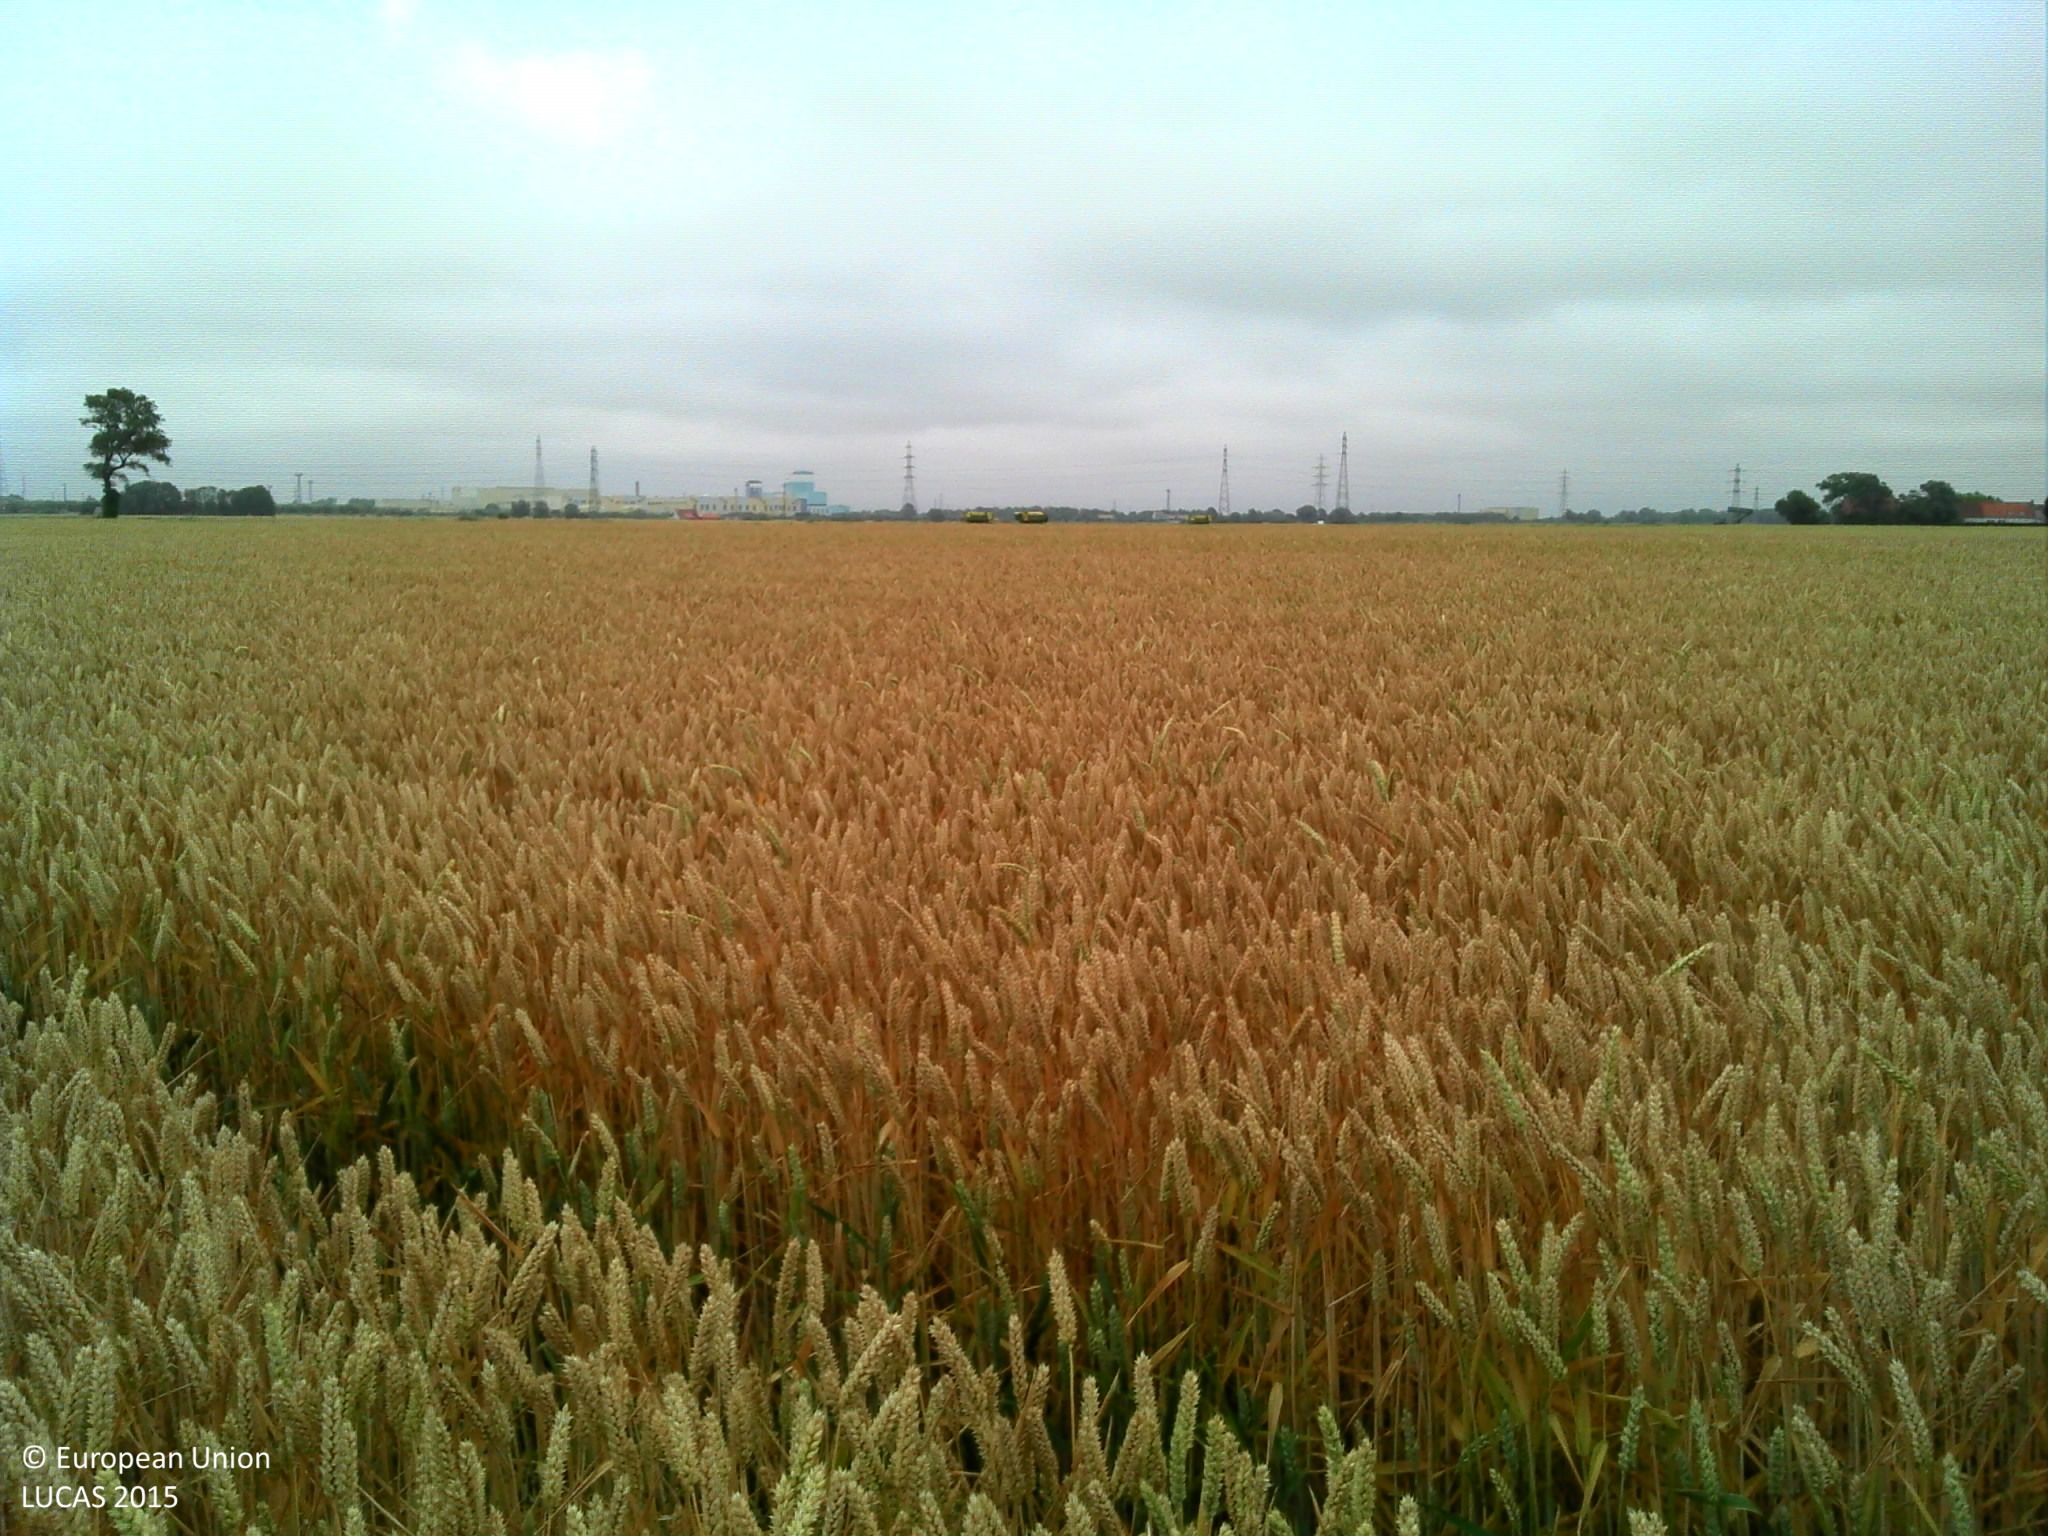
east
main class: Cropland
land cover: Common wheat
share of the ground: > 75 %
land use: Agriculture (excluding fallow land and kitchen gardens)
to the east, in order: Common wheat; Grass margins; Ditches and canals; Common wheat
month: July
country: FR
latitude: 50.9861
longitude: 2.2504
